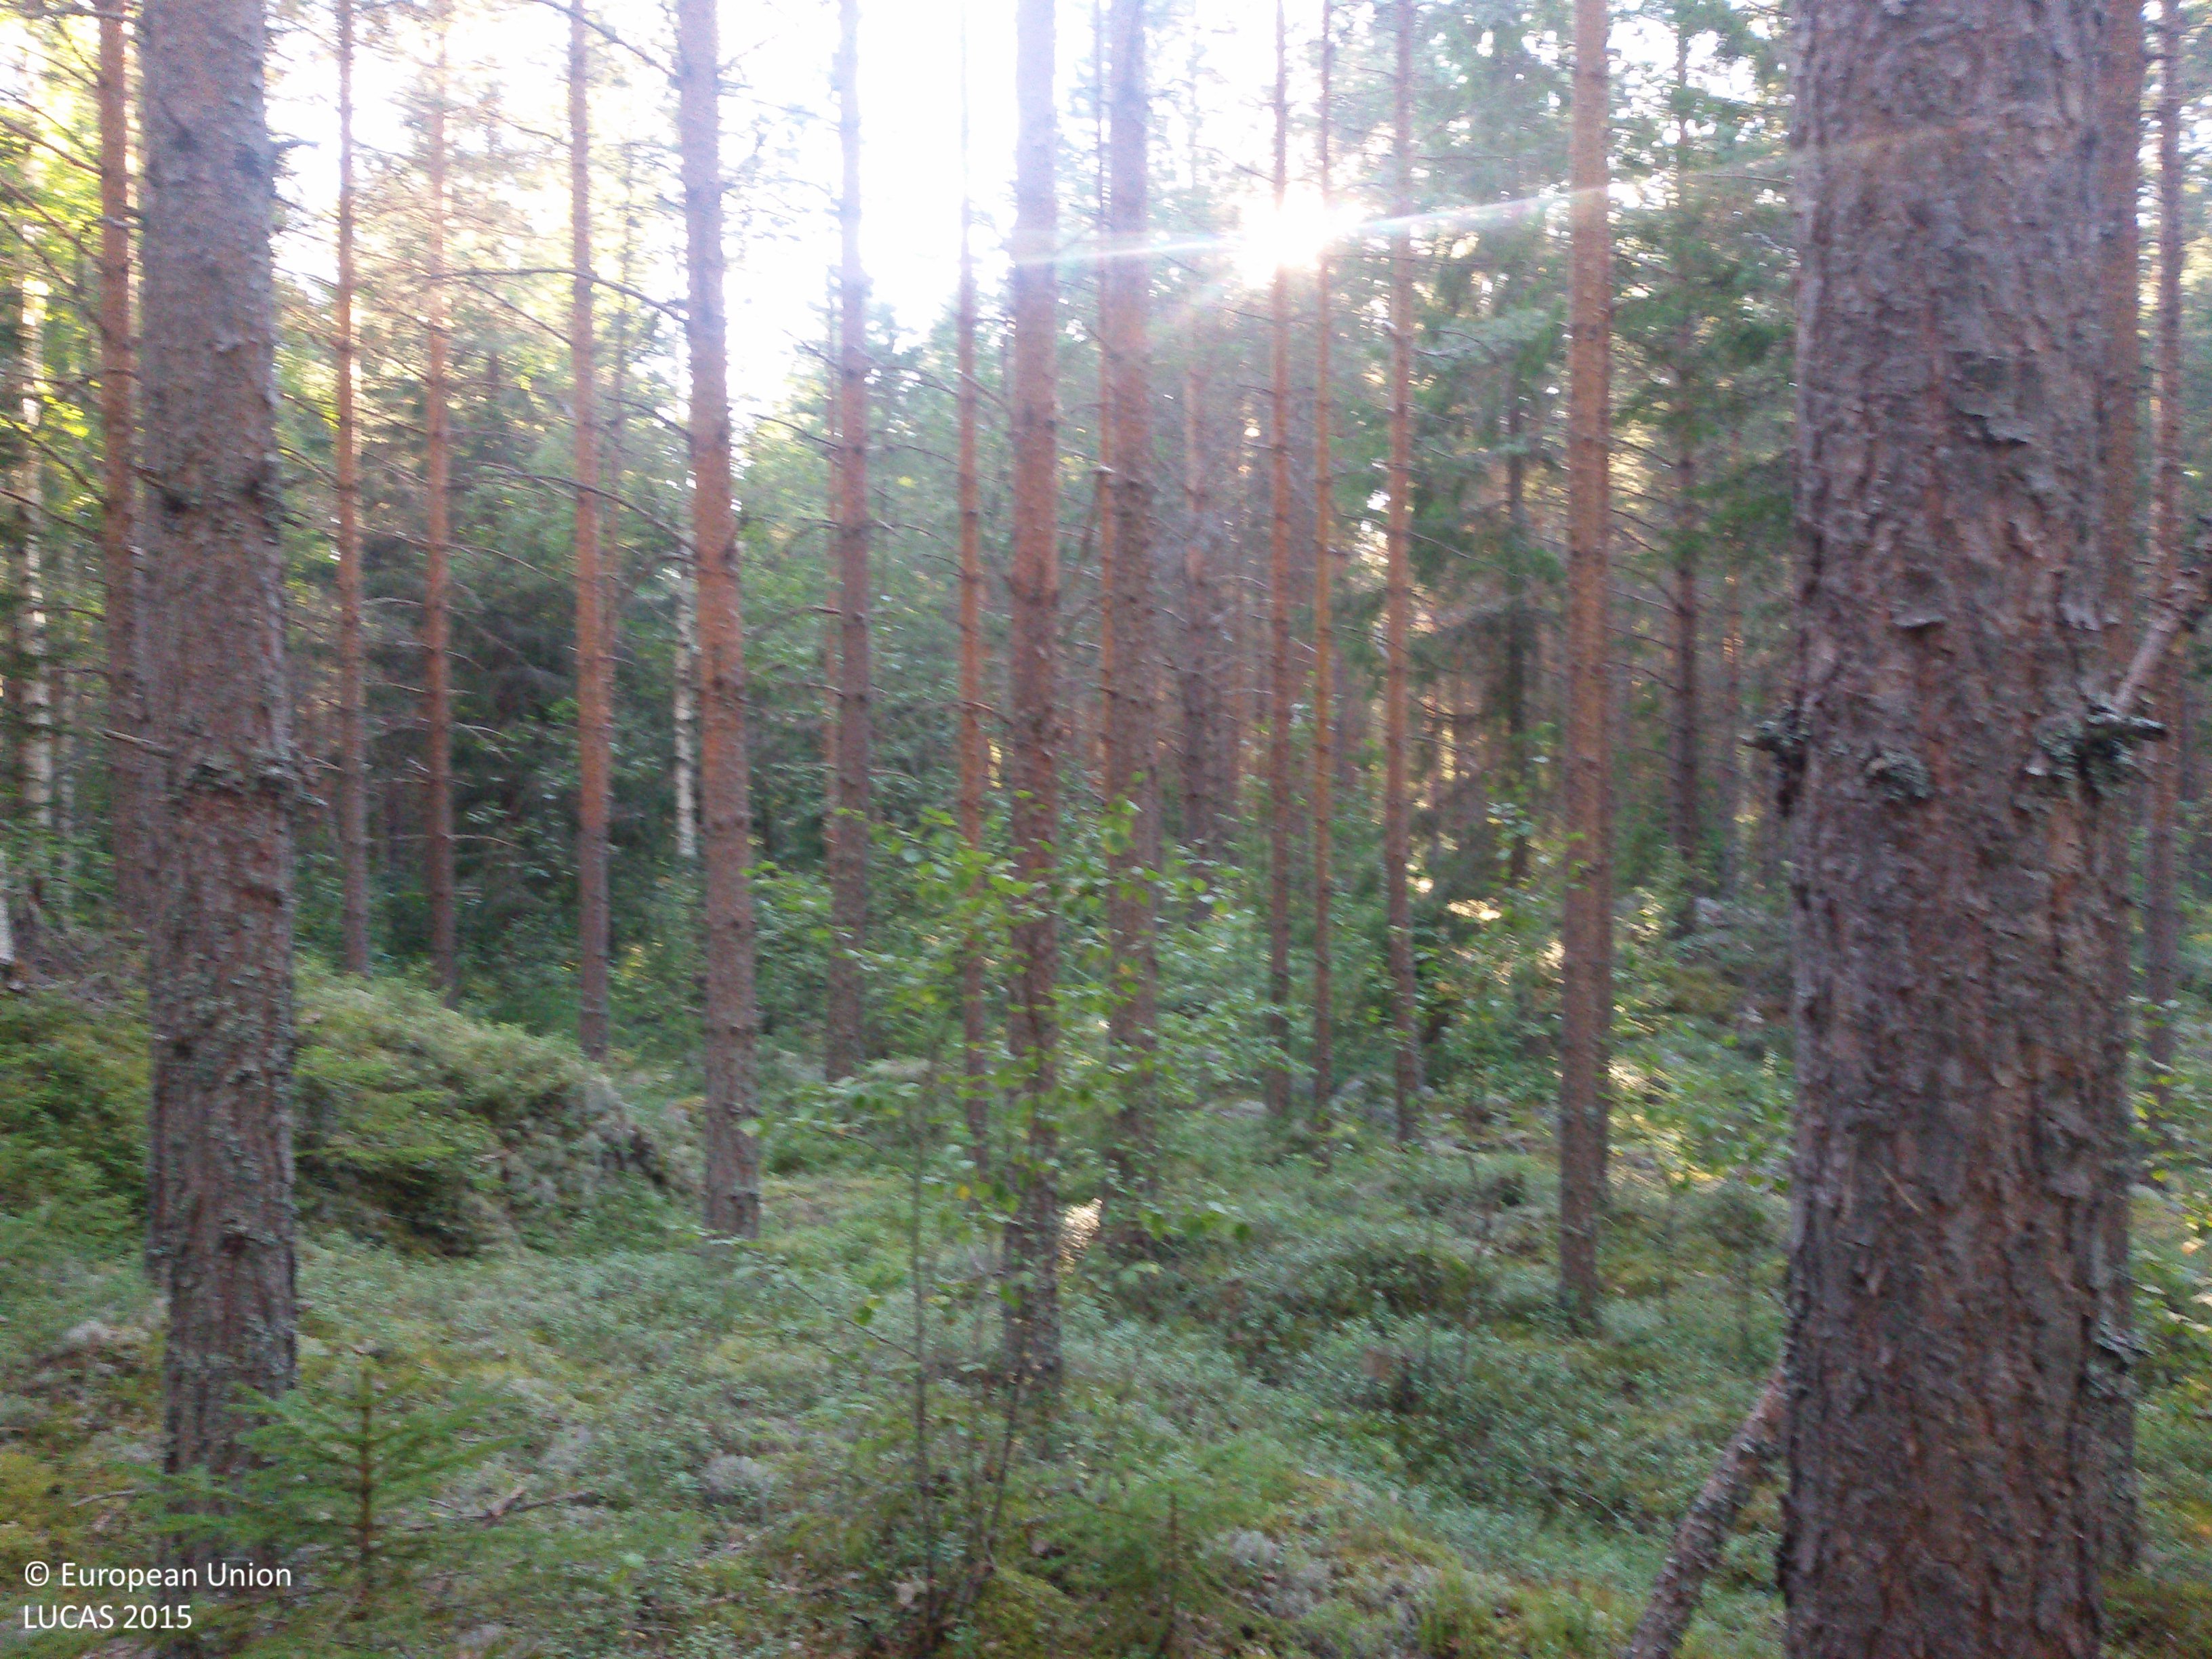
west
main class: Woodland
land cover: Pine dominated coniferous woodland
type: boreal forest
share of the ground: > 75 %
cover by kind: coniferous forest trees 80 %, lichens and mosses 15 %, shrubs 5 %
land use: Forestry
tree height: > 5 m
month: August
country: SE
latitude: 60.6893
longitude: 15.9020
